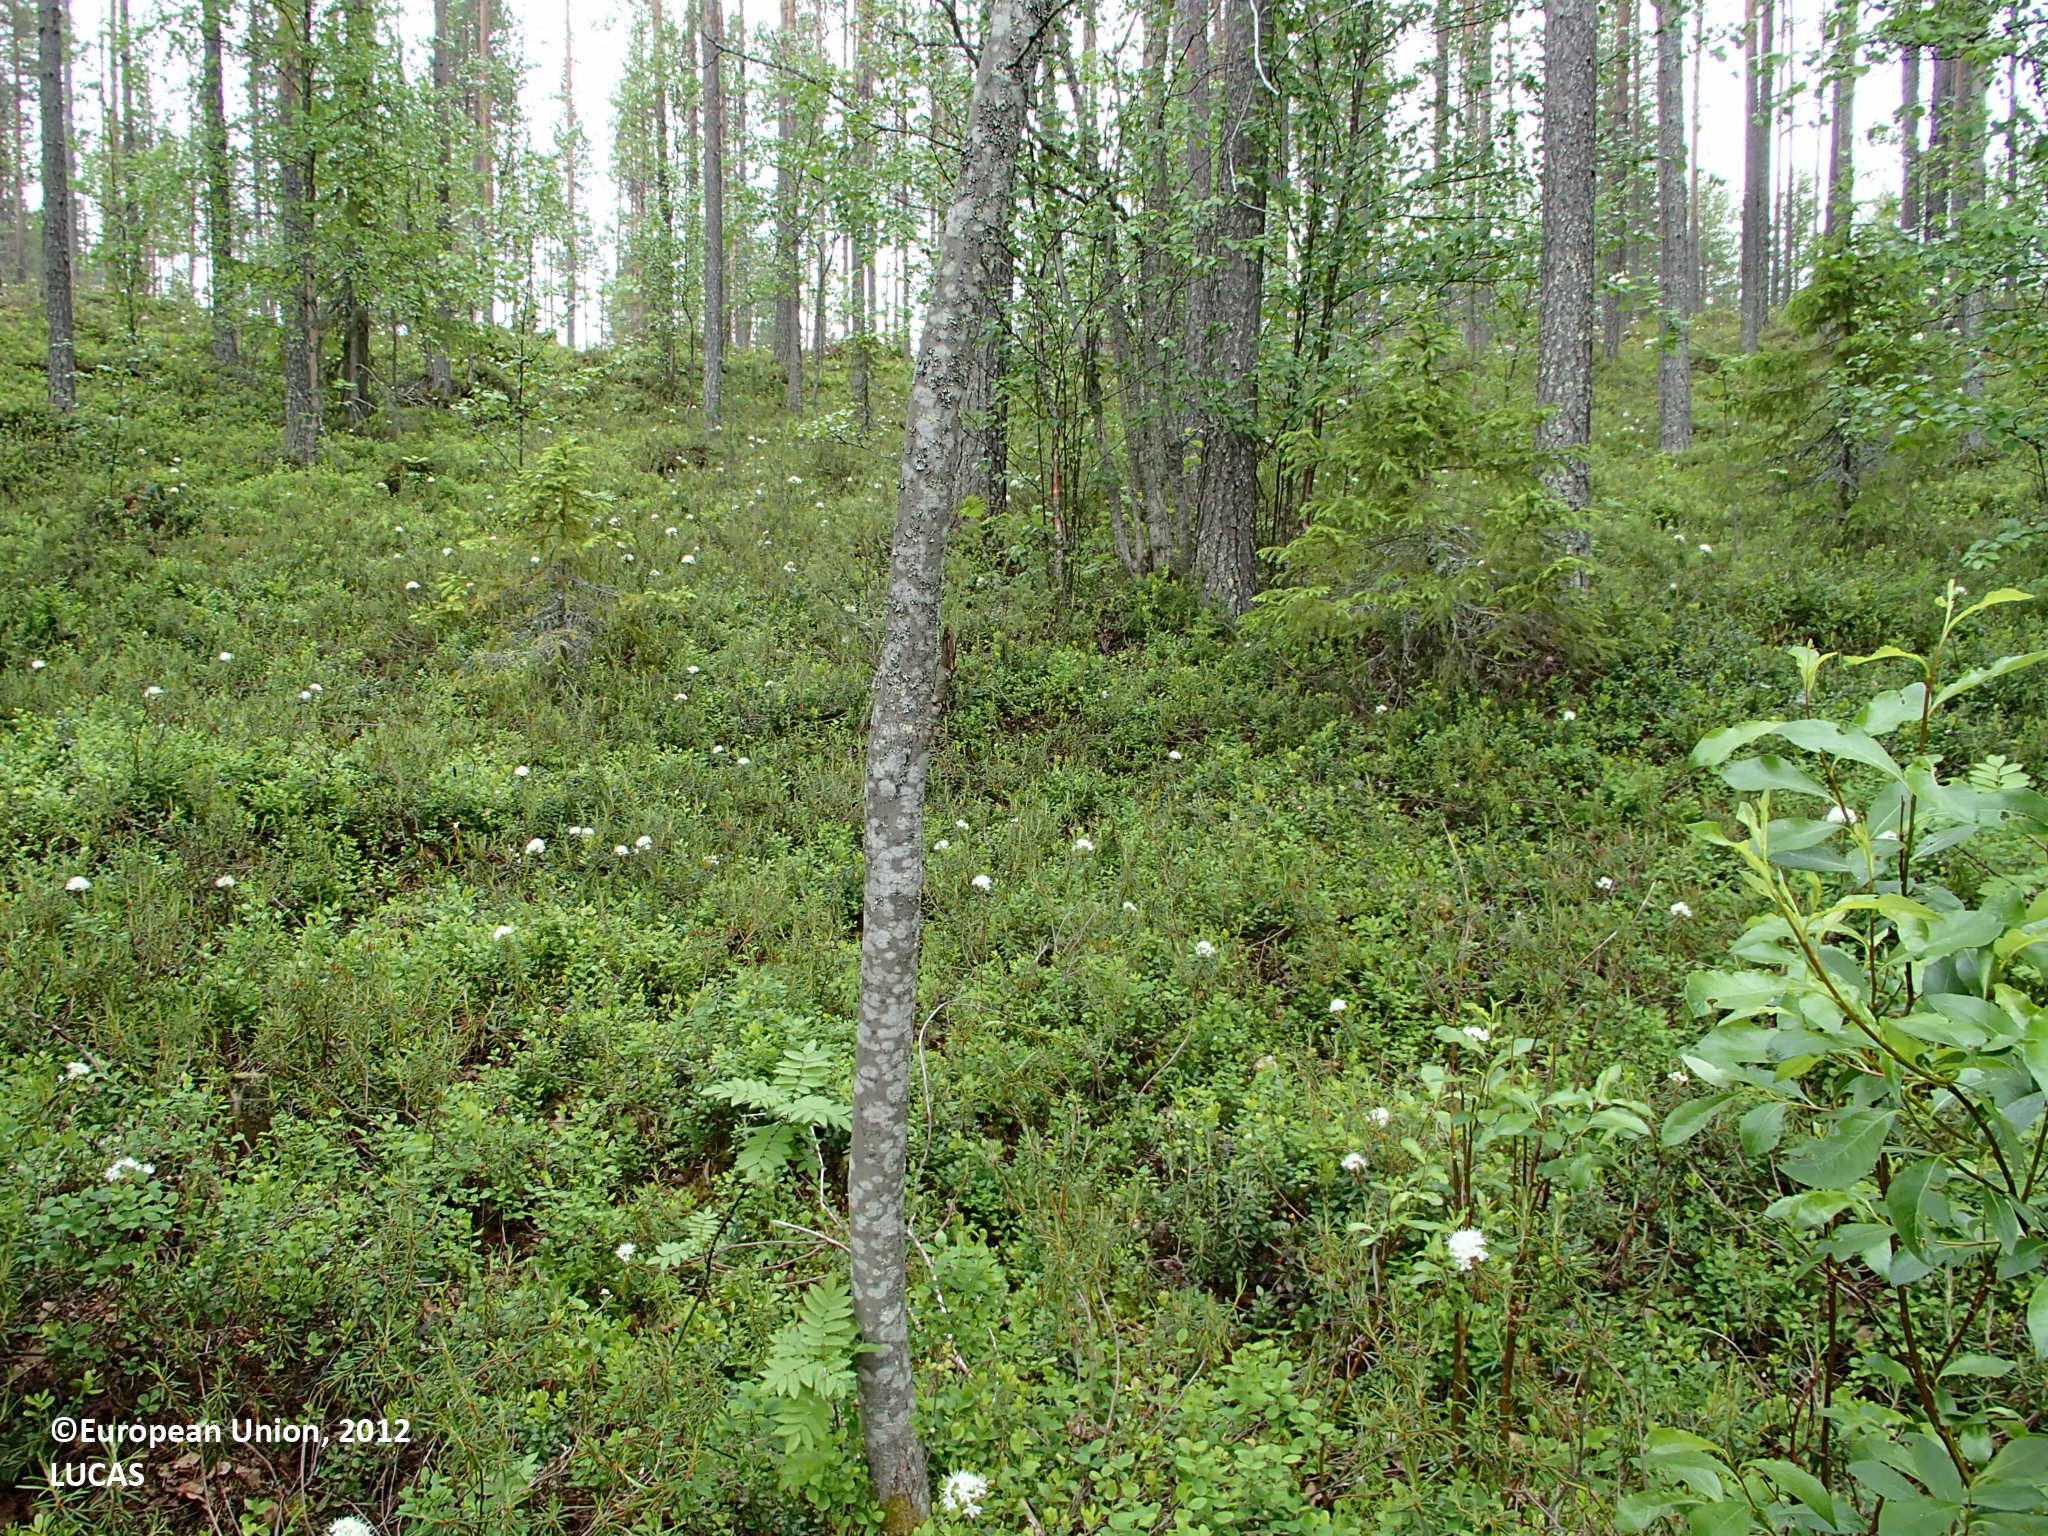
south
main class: Woodland
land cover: Pine dominated mixed woodland
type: boreal forest
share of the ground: > 75 %
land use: Forestry
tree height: > 5 m
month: June
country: FI
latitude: 66.5986
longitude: 27.6952
